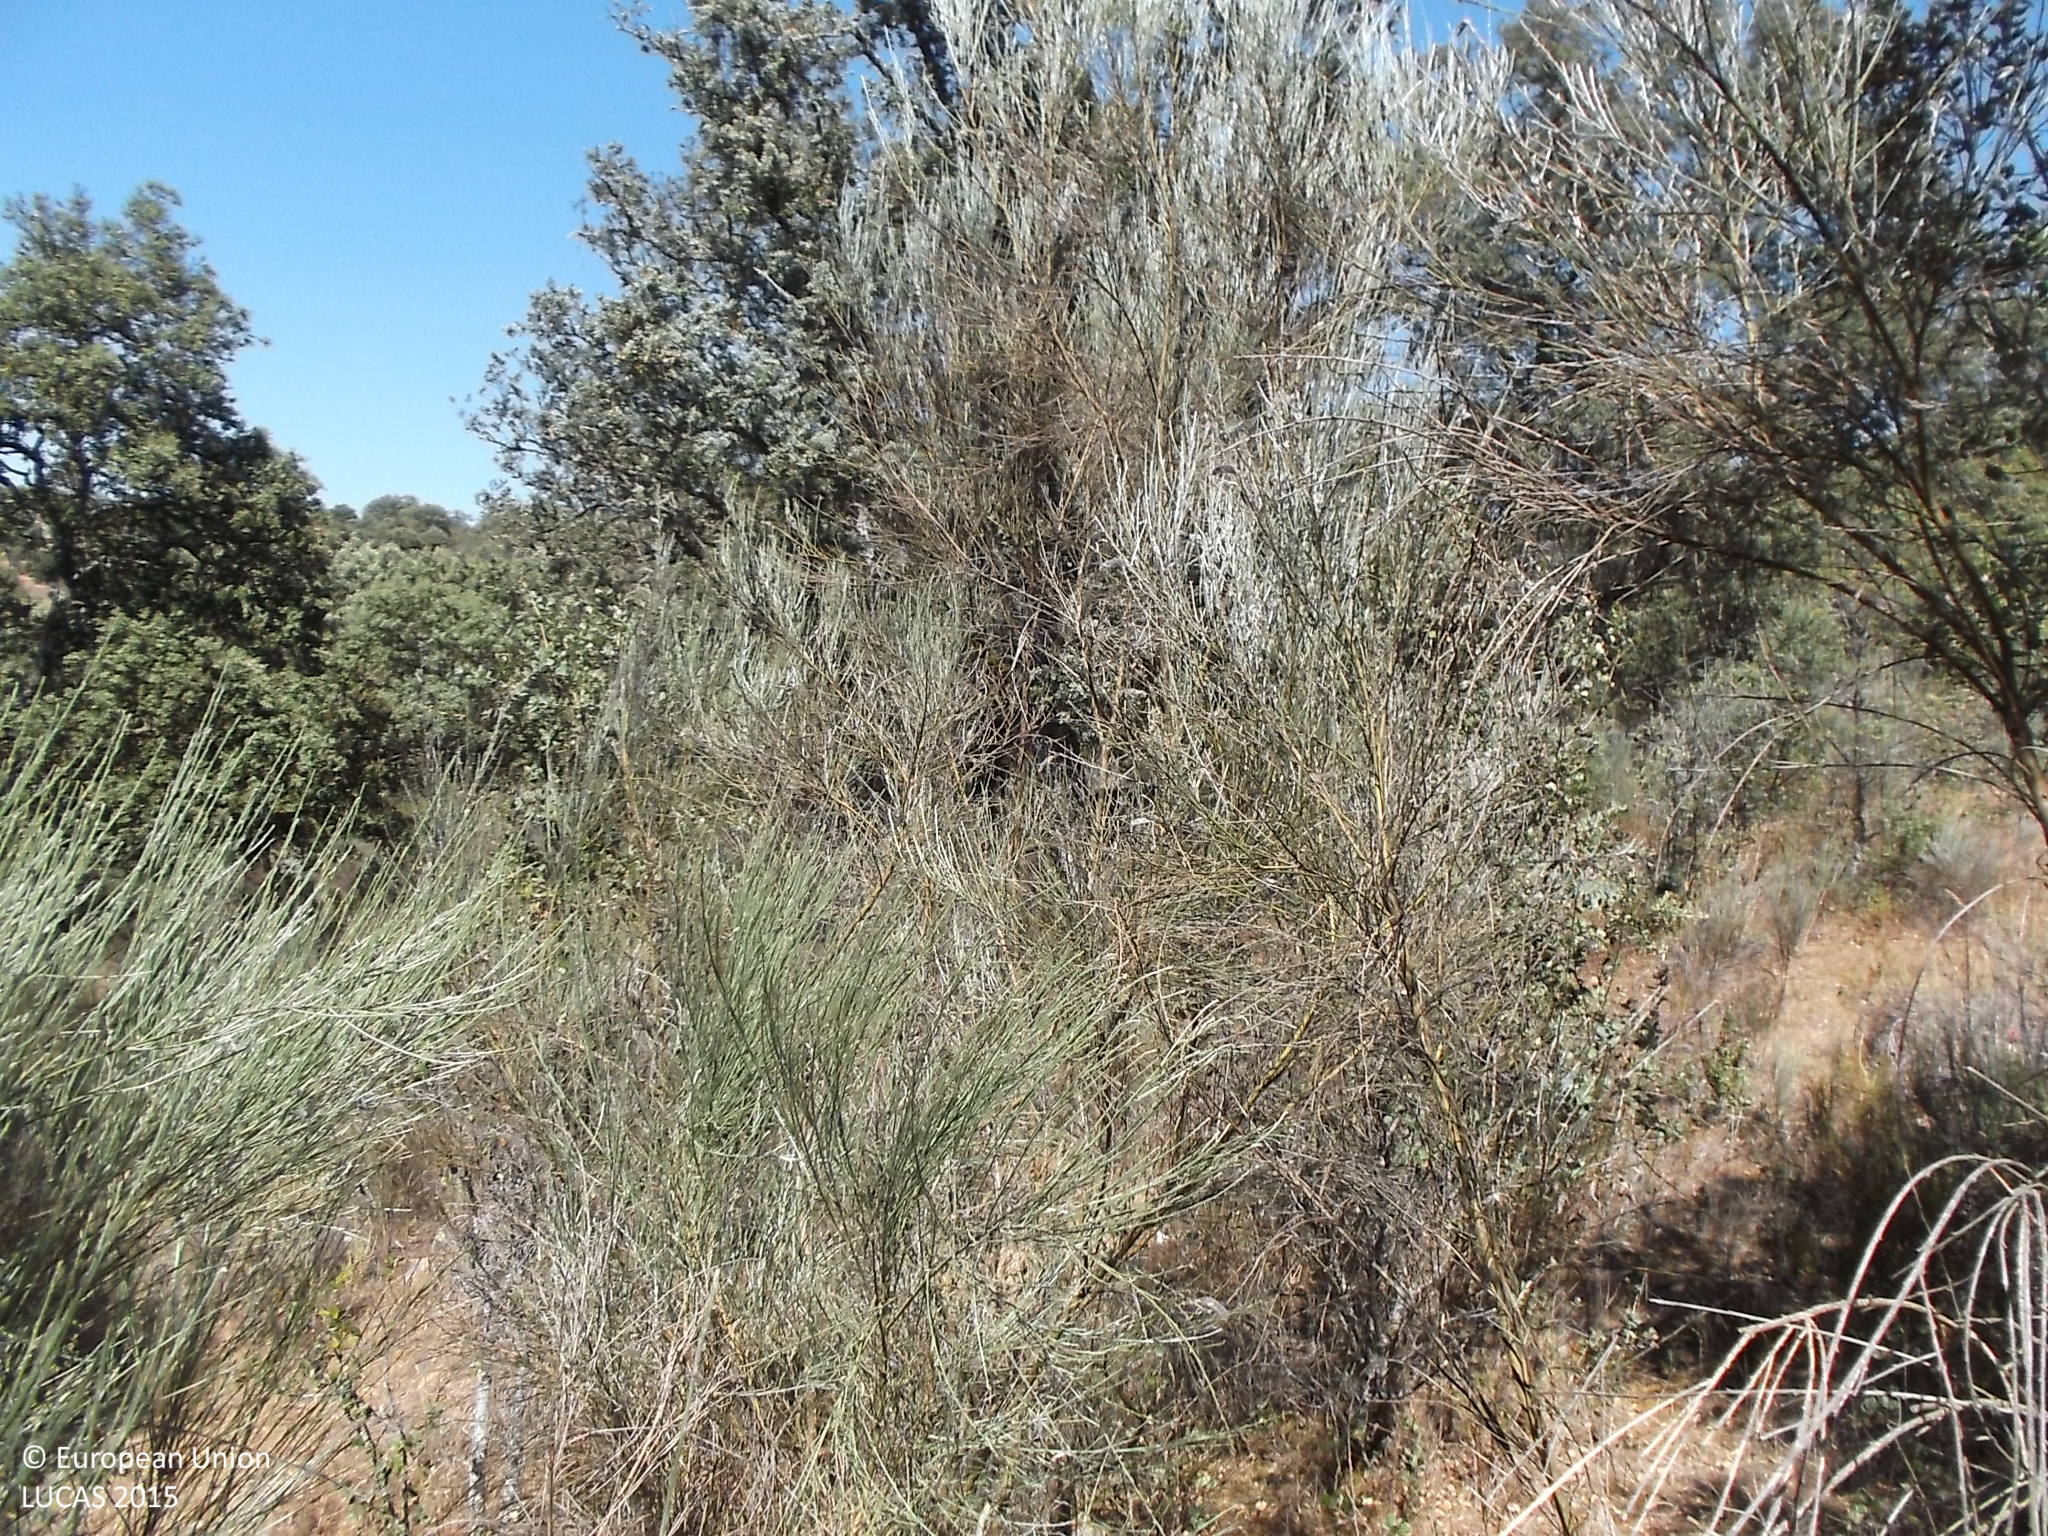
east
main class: Woodland
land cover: Broadleaved woodland
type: broadleaved evergreen forest
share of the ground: 50 - 75 %
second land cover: Shrubland without tree cover
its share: 50 - 75 %
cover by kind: broadleaved forest trees 60 %, shrubs 40 %
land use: Forestry
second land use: Agriculture (excluding fallow land and kitchen gardens)
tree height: < 5 m
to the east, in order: Broadleaved woodland; Shrubland without tree cover; Dry stone walls; Broadleaved woodland; Fences; Tracks; Broadleaved woodland; Shrubland with sparse tree cover; Fences; Tracks; Fences; Broadleaved woodland
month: July
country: ES
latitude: 40.7269
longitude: -6.7796
